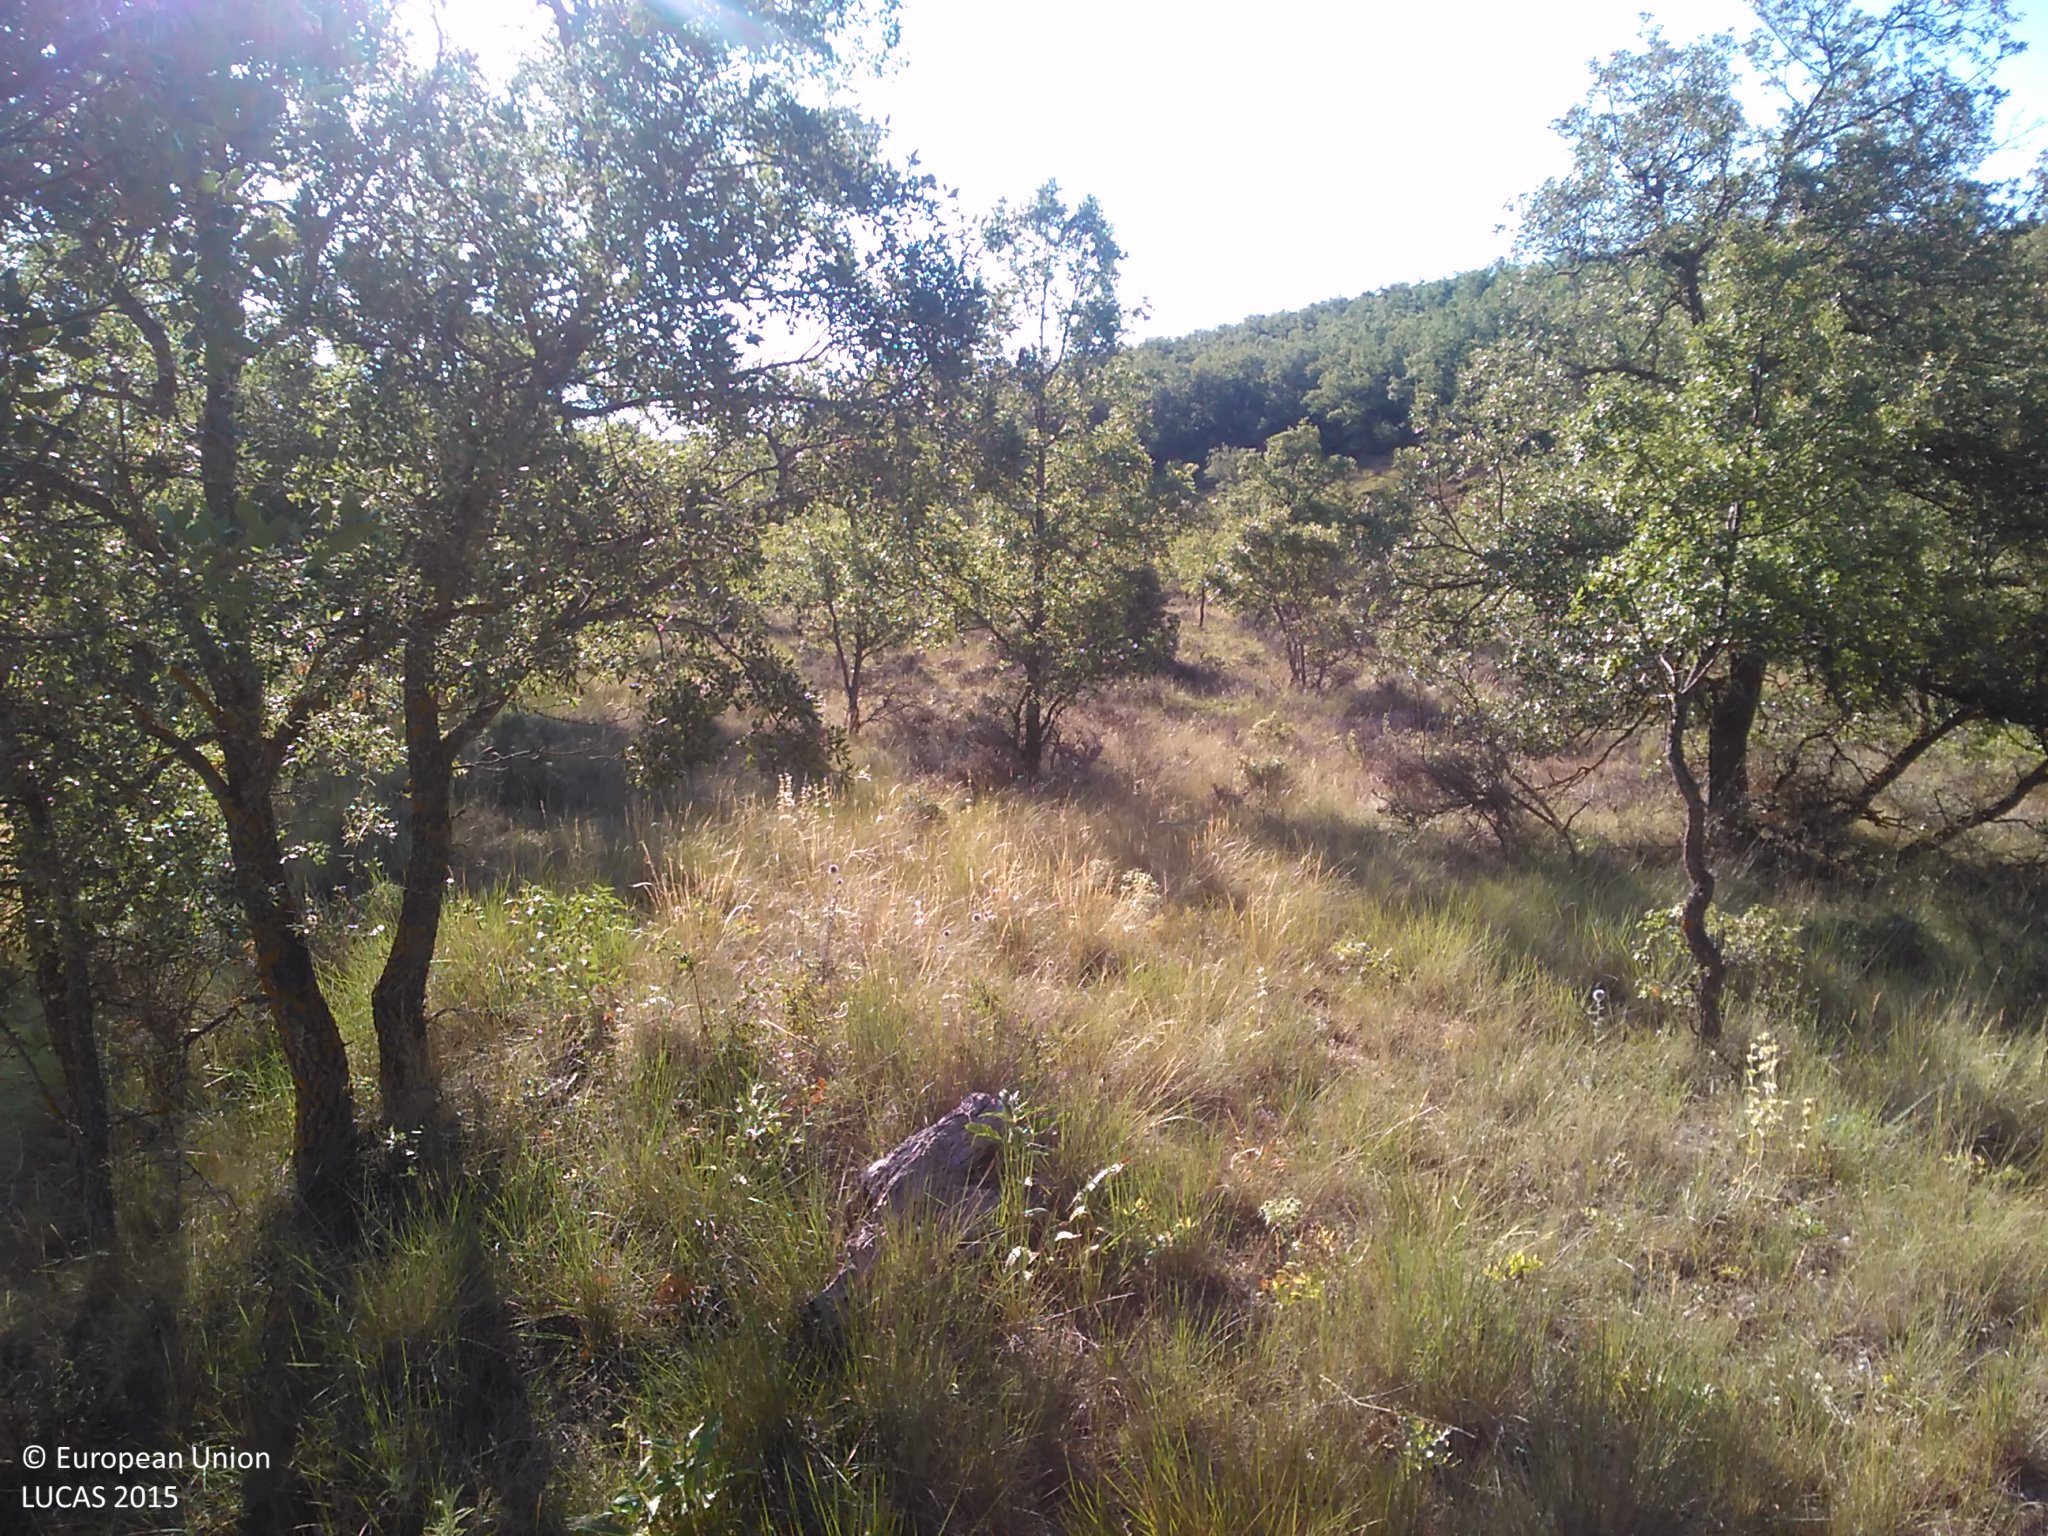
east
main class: Woodland
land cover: Broadleaved woodland
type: broadleaved evergreen forest
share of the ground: 25 - 50 %
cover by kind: broadleaved forest trees 40 %, herbaceous plants 35 %, unconsolidated bare surface 20 %, shrubs 5 %
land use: Semi-natural and natural areas not in use
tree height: > 5 m
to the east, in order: Broadleaved woodland
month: July
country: ES
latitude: 41.5008
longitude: -2.1431
